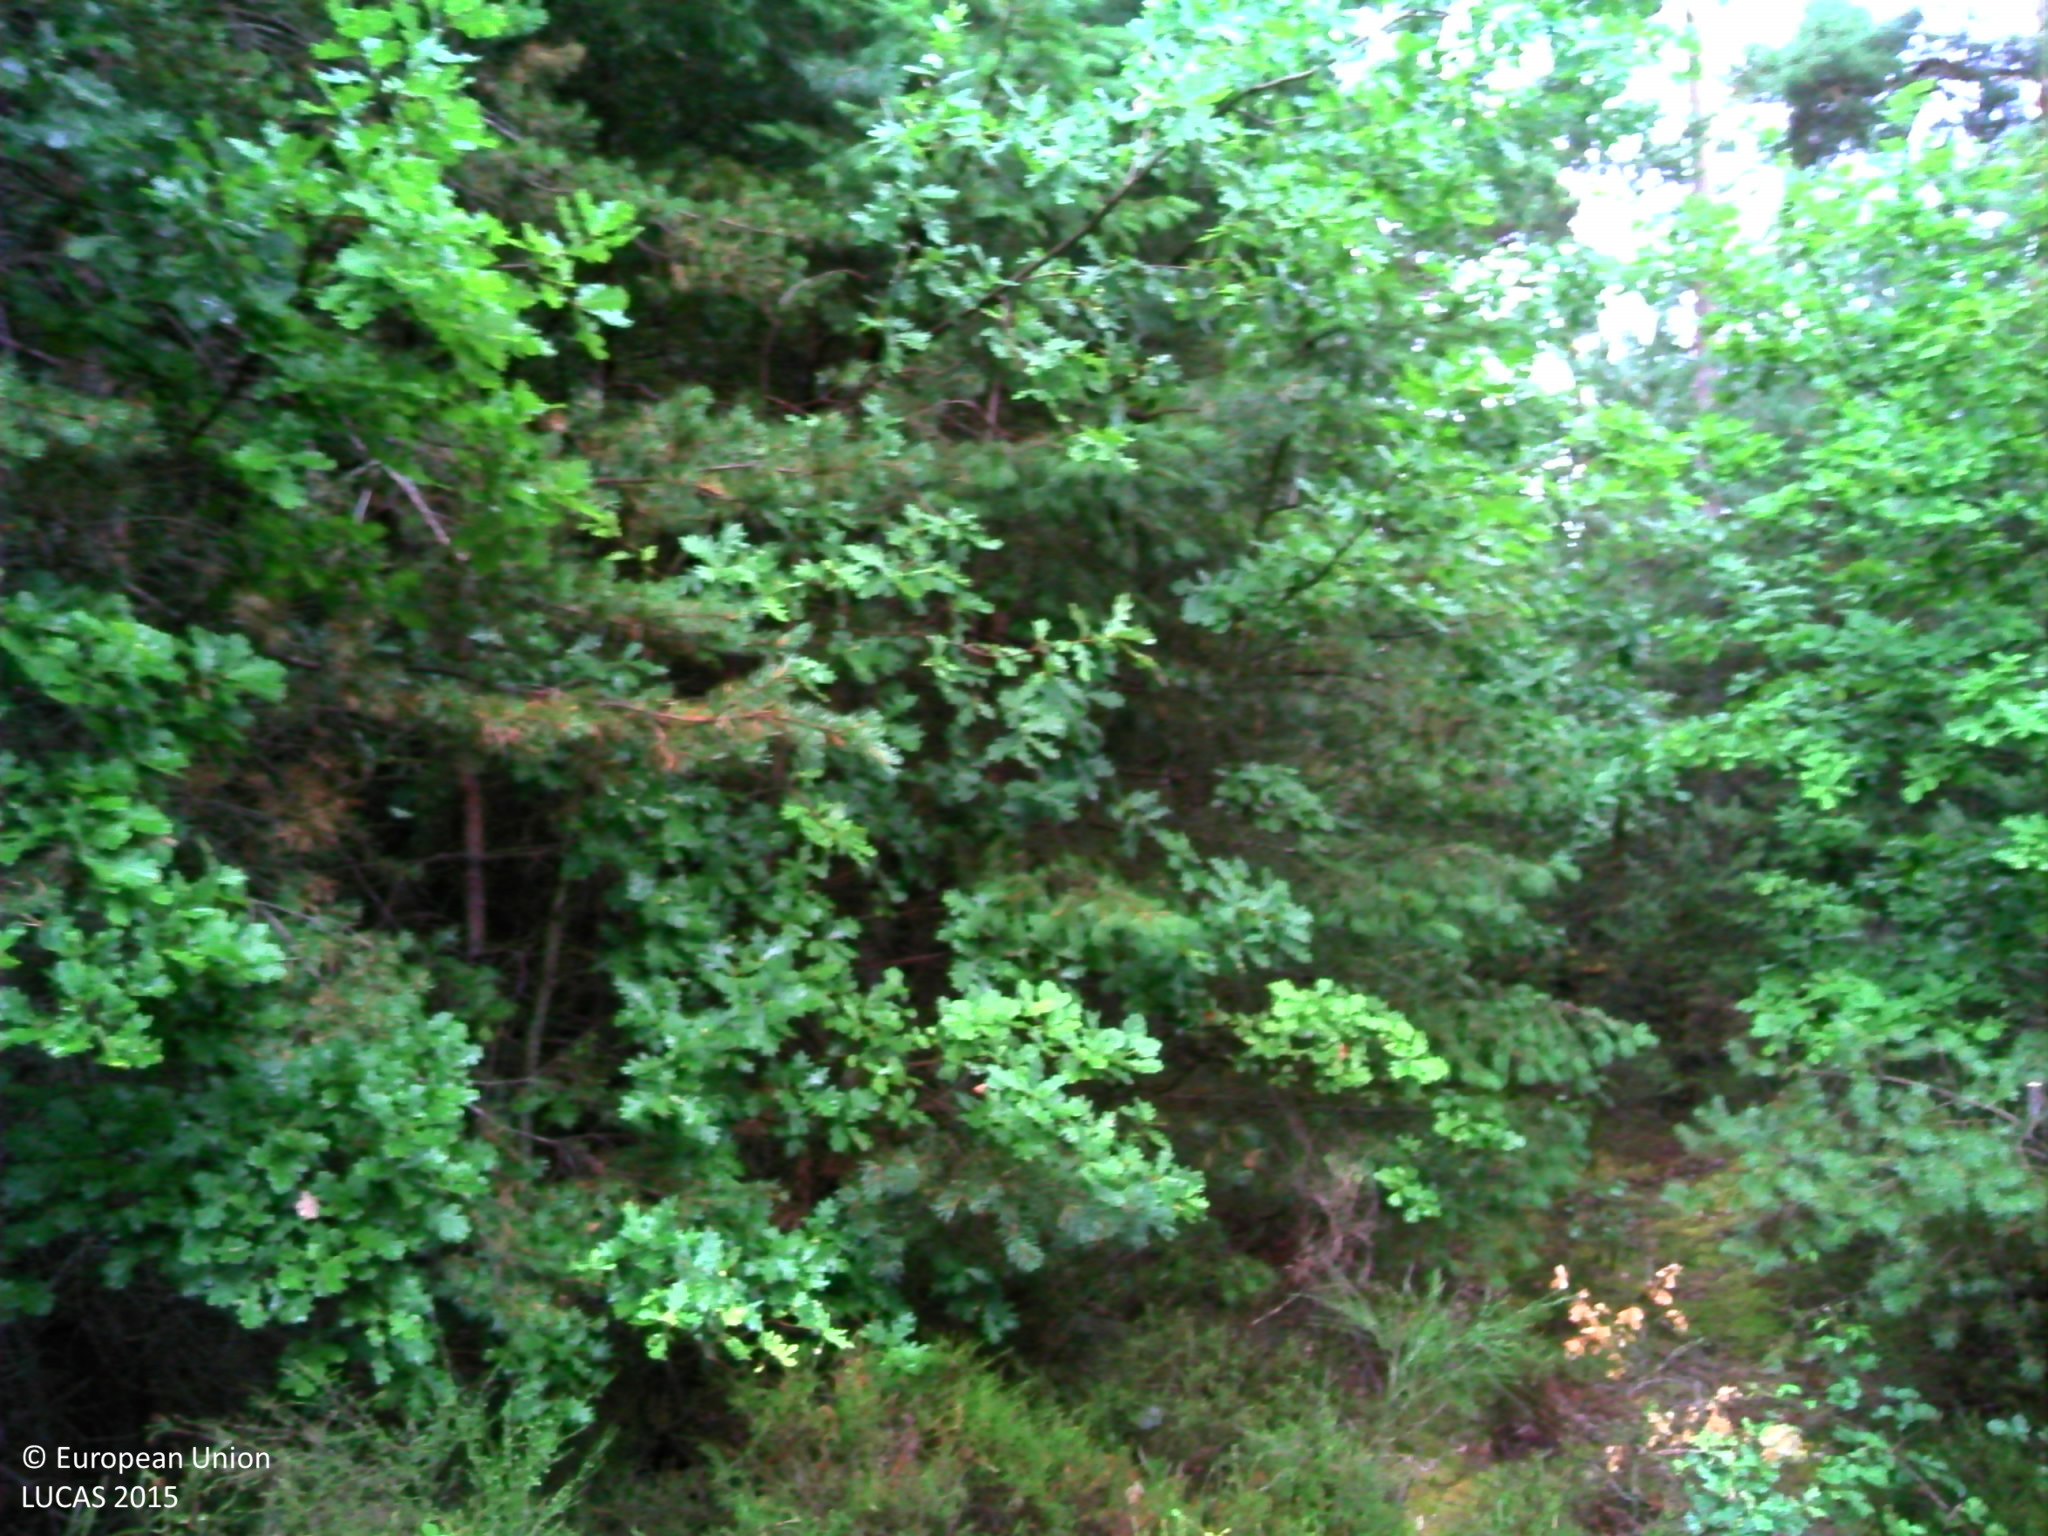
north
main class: Woodland
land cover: Broadleaved woodland
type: thermophilous deciduous forest
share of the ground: > 75 %
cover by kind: broadleaved forest trees 65 %, coniferous forest trees 10 %, shrubs 10 %, lichens and mosses 10 %, herbaceous plants 5 %
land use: Forestry
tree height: > 5 m
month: July
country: FR
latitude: 45.4691
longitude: 4.1580
